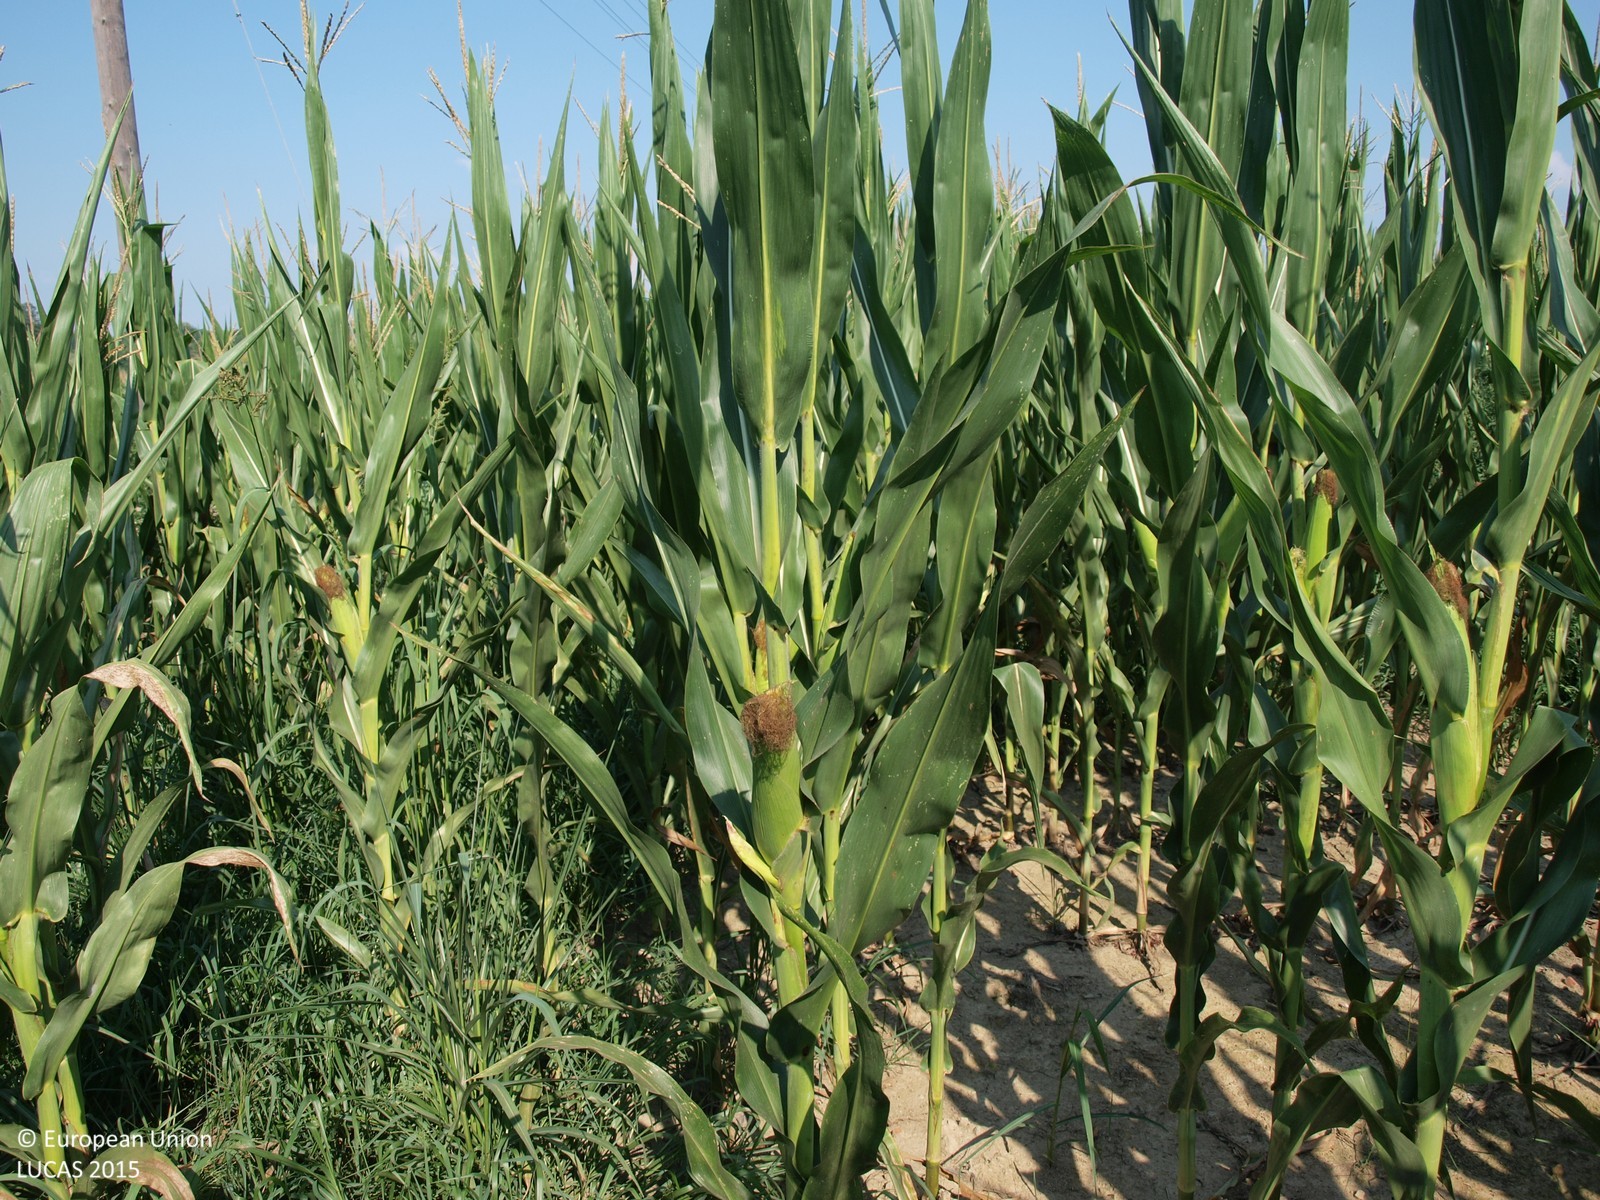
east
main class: Cropland
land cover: Maize
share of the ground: > 75 %
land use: Agriculture (excluding fallow land and kitchen gardens)
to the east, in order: Maize; Electric lines; Grass margins; Tracks; Grass margins; Maize; Spontaneously vegetated surfaces; Maize; Common wheat; Maize
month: August
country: HR
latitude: 45.8641
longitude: 16.5042
